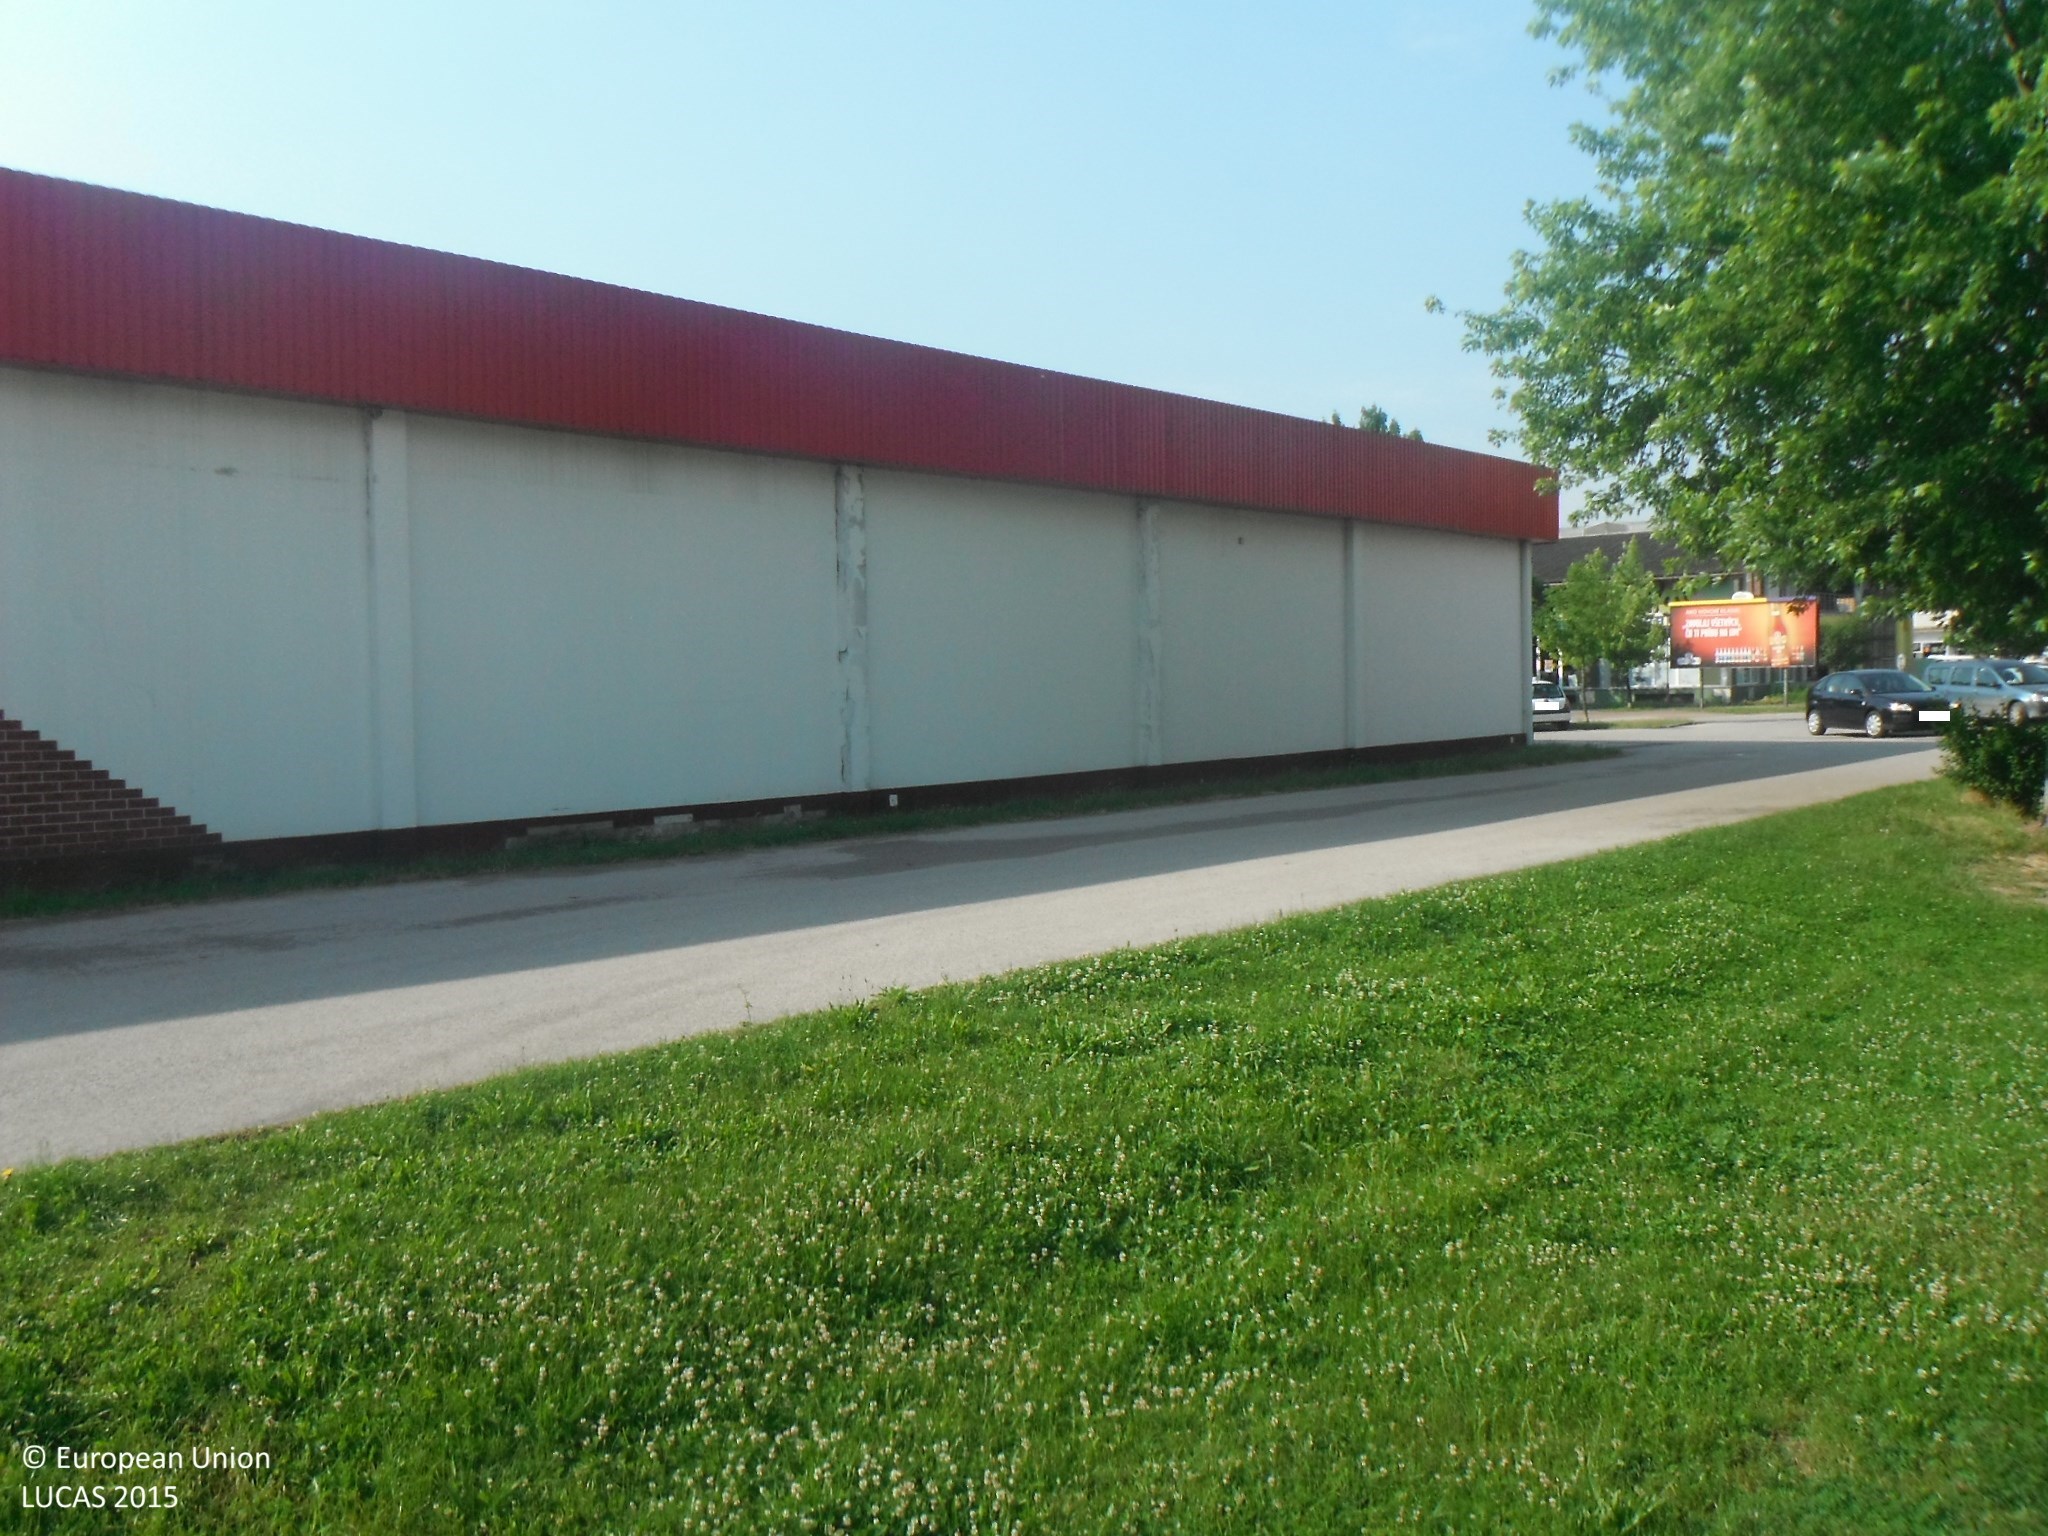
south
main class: Grassland
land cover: Grassland with sparse tree/shrub cover
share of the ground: > 75 %
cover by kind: herbaceous plants 95 %, broadleaved forest trees 5 %
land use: Residential
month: June
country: SK
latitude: 48.1584
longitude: 17.8765
